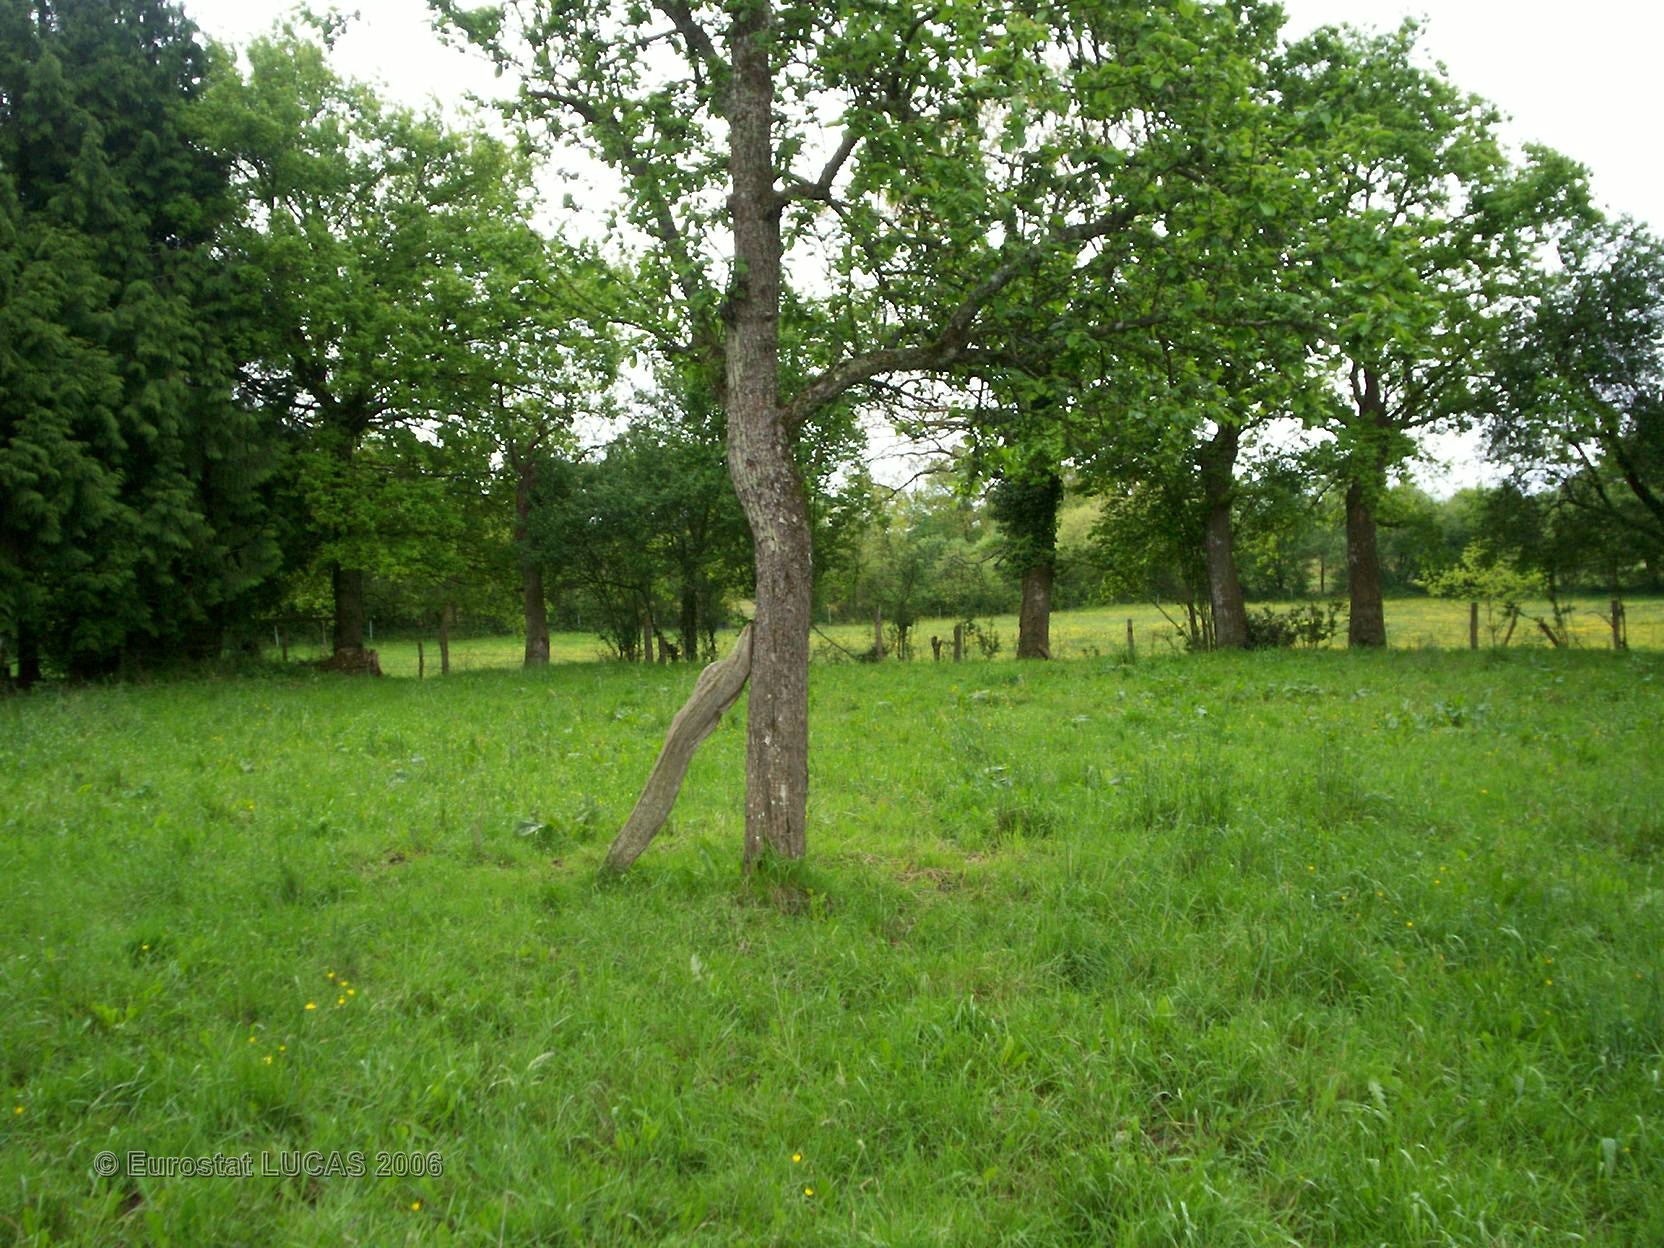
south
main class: Grassland
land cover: Grassland with sparse tree/shrub cover
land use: Agriculture (excluding fallow land and kitchen gardens)
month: May
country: FR
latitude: 48.6612
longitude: -0.3383
